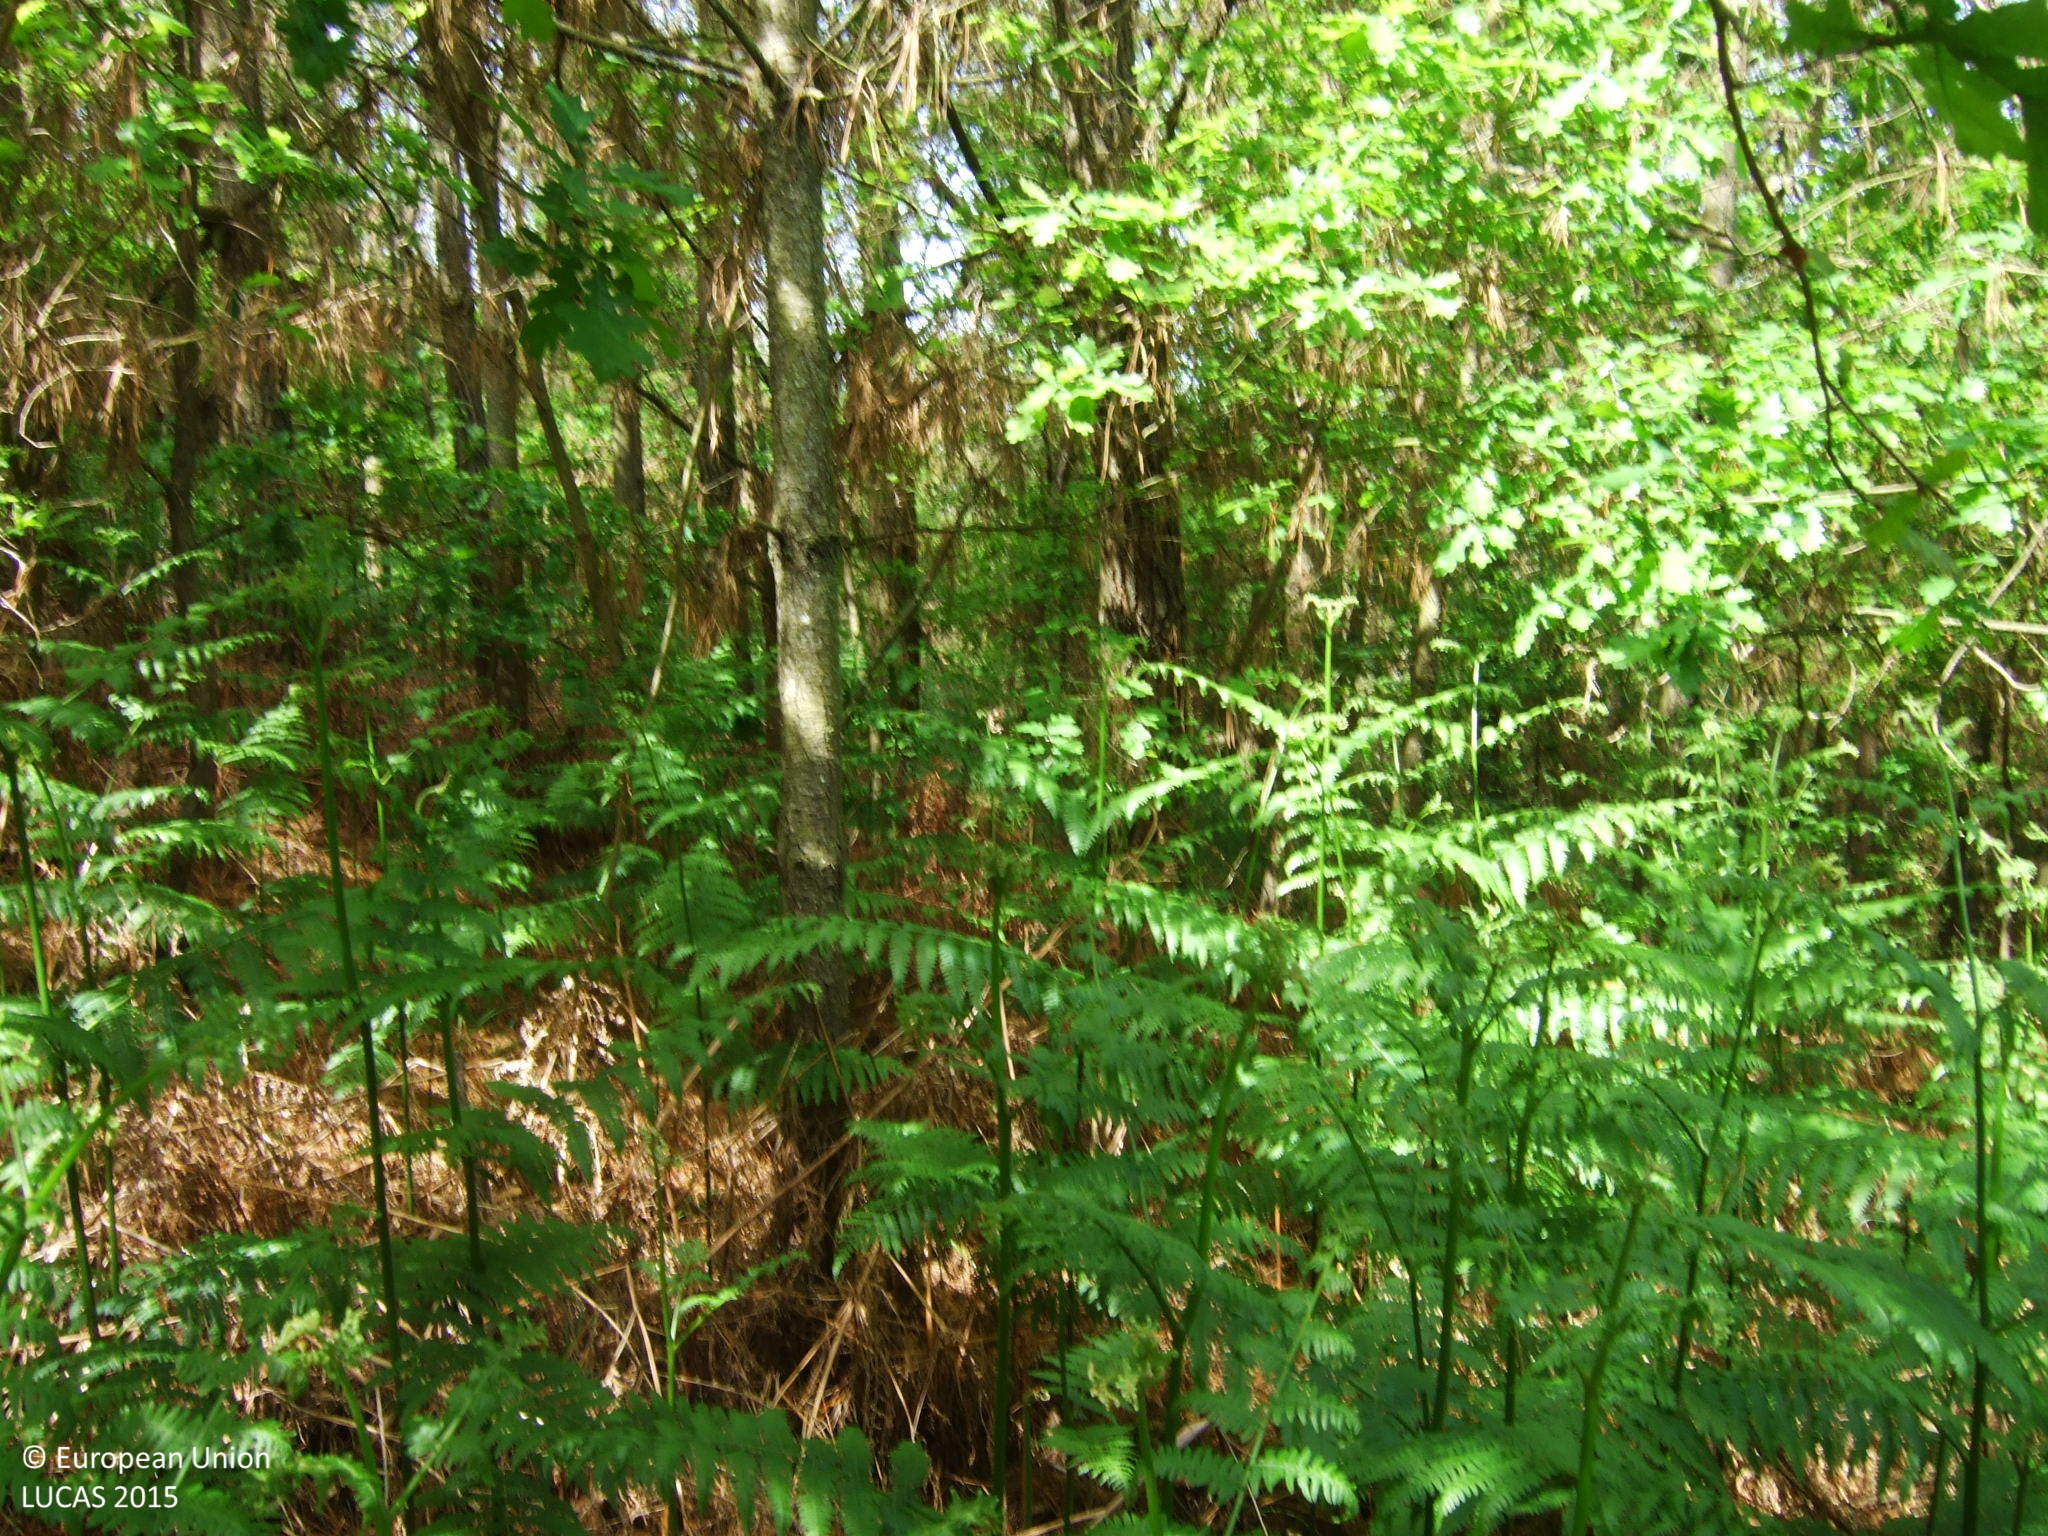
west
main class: Woodland
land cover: Broadleaved woodland
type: acidophilous oak and oak-birch forest
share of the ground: > 75 %
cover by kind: broadleaved forest trees 90 %, shrubs 10 %
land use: Forestry
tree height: > 5 m
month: May
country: ES
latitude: 42.9073
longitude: -7.3779
